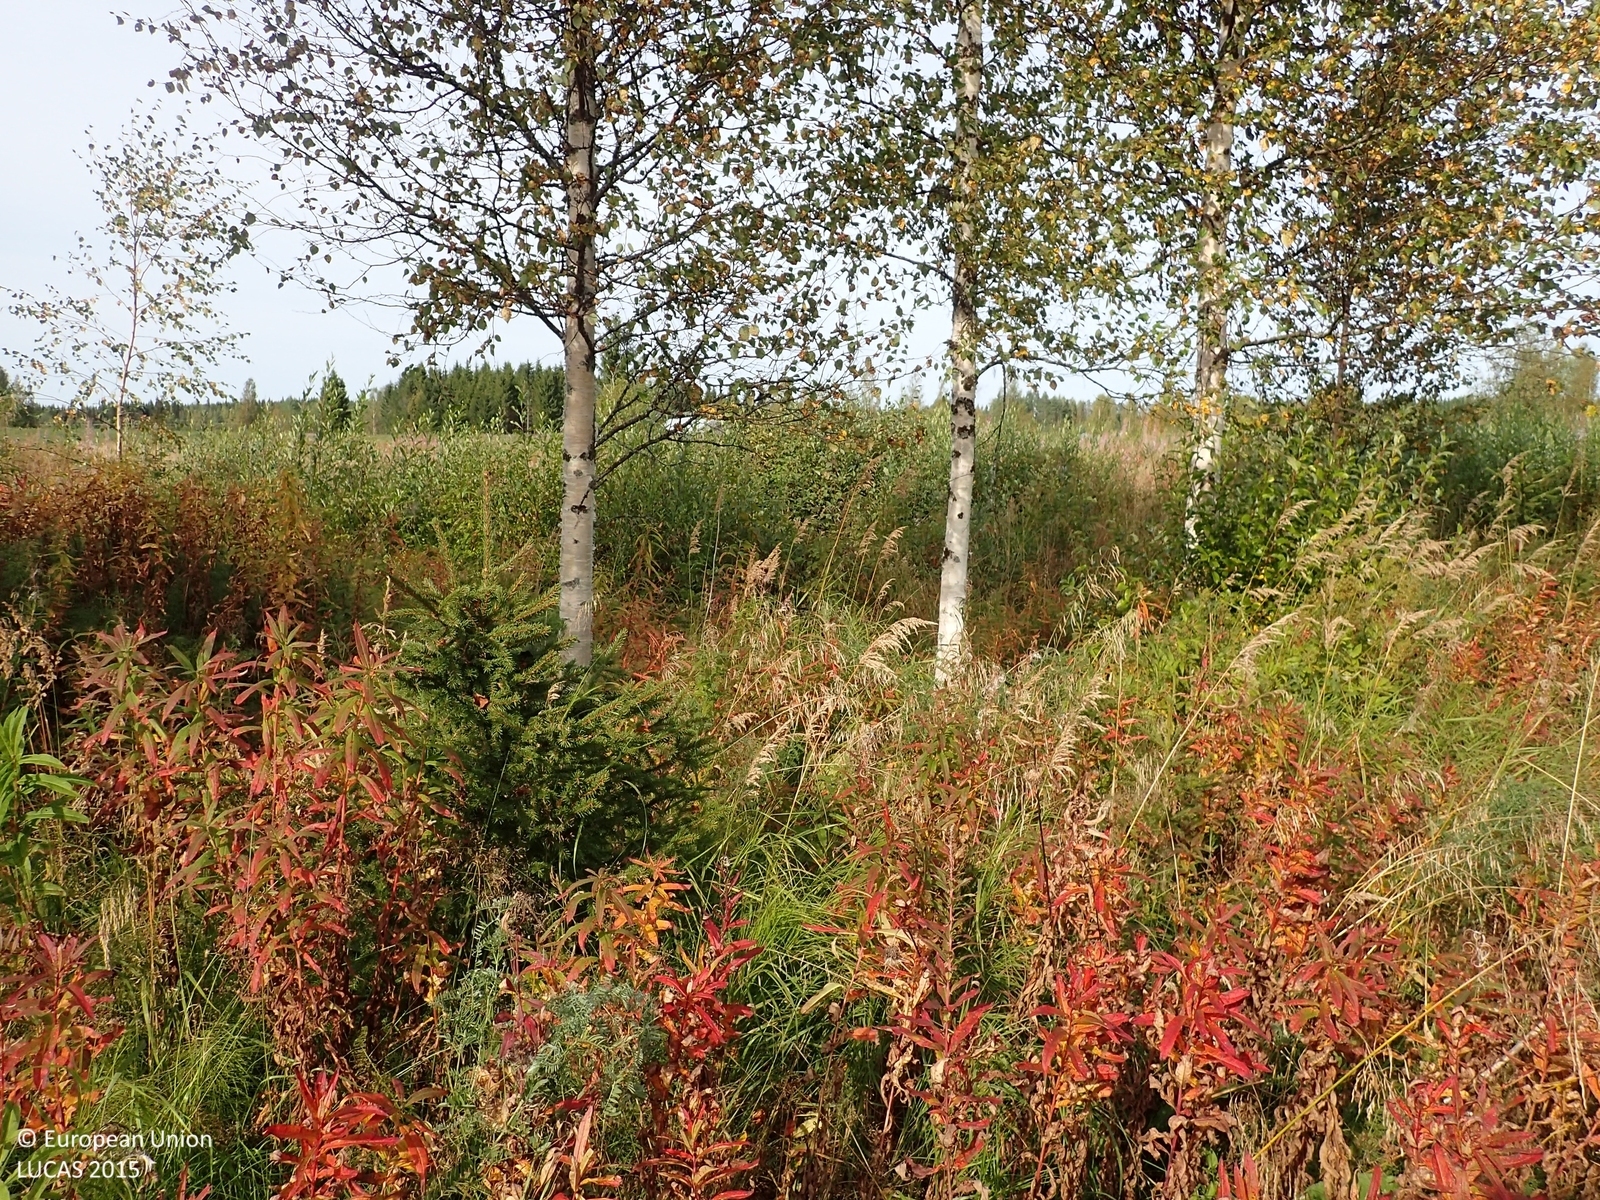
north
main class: Woodland
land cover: Broadleaved woodland
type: non-riverine alder, birch or aspen forest
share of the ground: 10 - 25 %
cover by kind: herbaceous plants 85 %, broadleaved forest trees 15 %
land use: Semi-natural and natural areas not in use
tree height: < 5 m
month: September
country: FI
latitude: 63.0300
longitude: 26.1105
